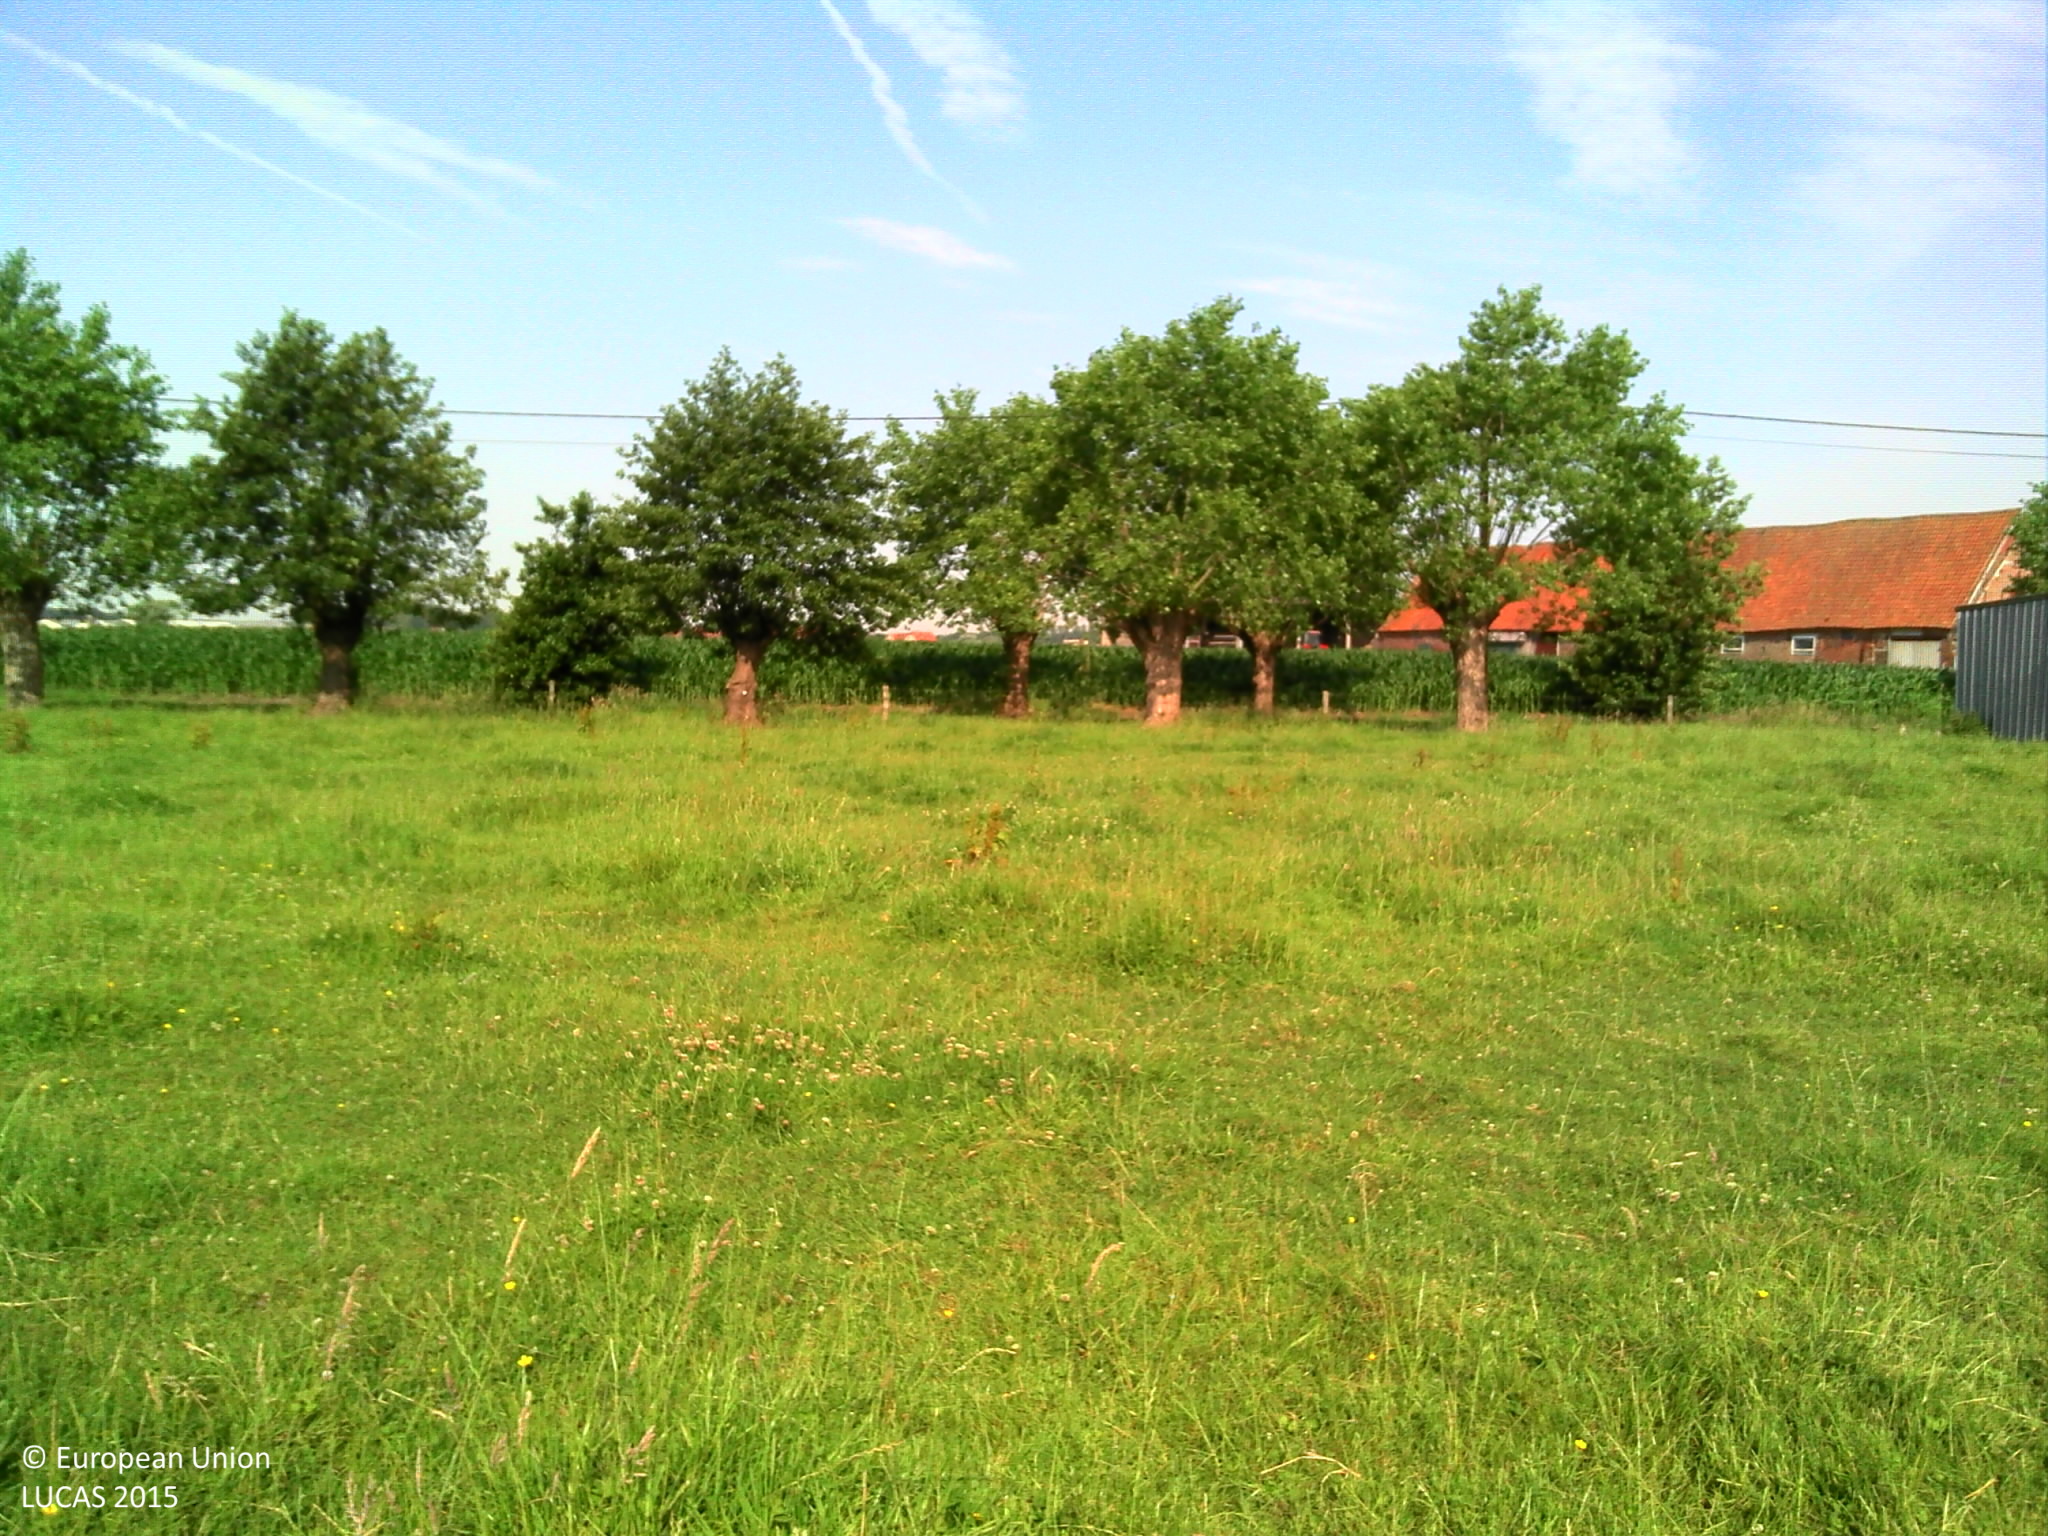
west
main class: Grassland
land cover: Grassland without tree/shrub cover
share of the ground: > 75 %
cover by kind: herbaceous plants 100 %
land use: Agriculture (excluding fallow land and kitchen gardens)
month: July
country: BE
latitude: 51.0777
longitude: 3.4403
